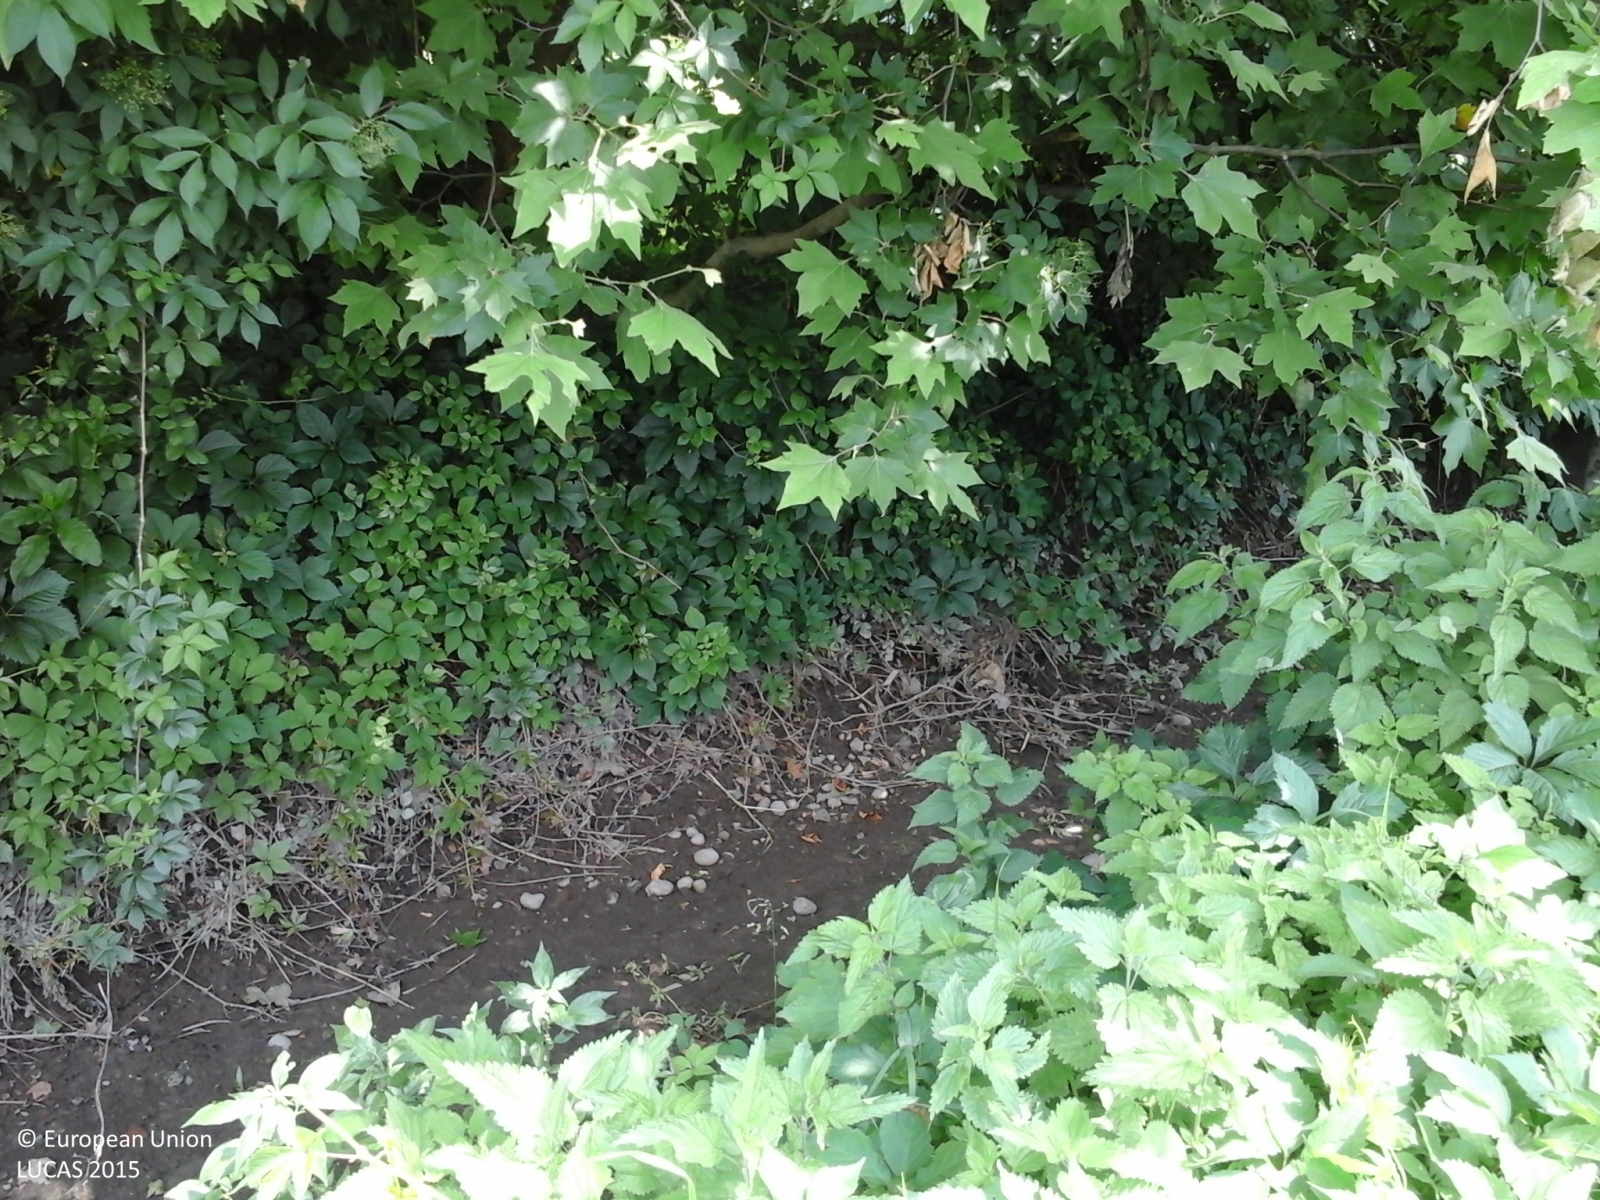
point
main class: Woodland
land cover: Broadleaved woodland
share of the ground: > 75 %
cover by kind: broadleaved forest trees 50 %, herbaceous plants 50 %
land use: Agriculture (excluding fallow land and kitchen gardens)
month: May
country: IT
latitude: 45.4856
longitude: 9.6041
